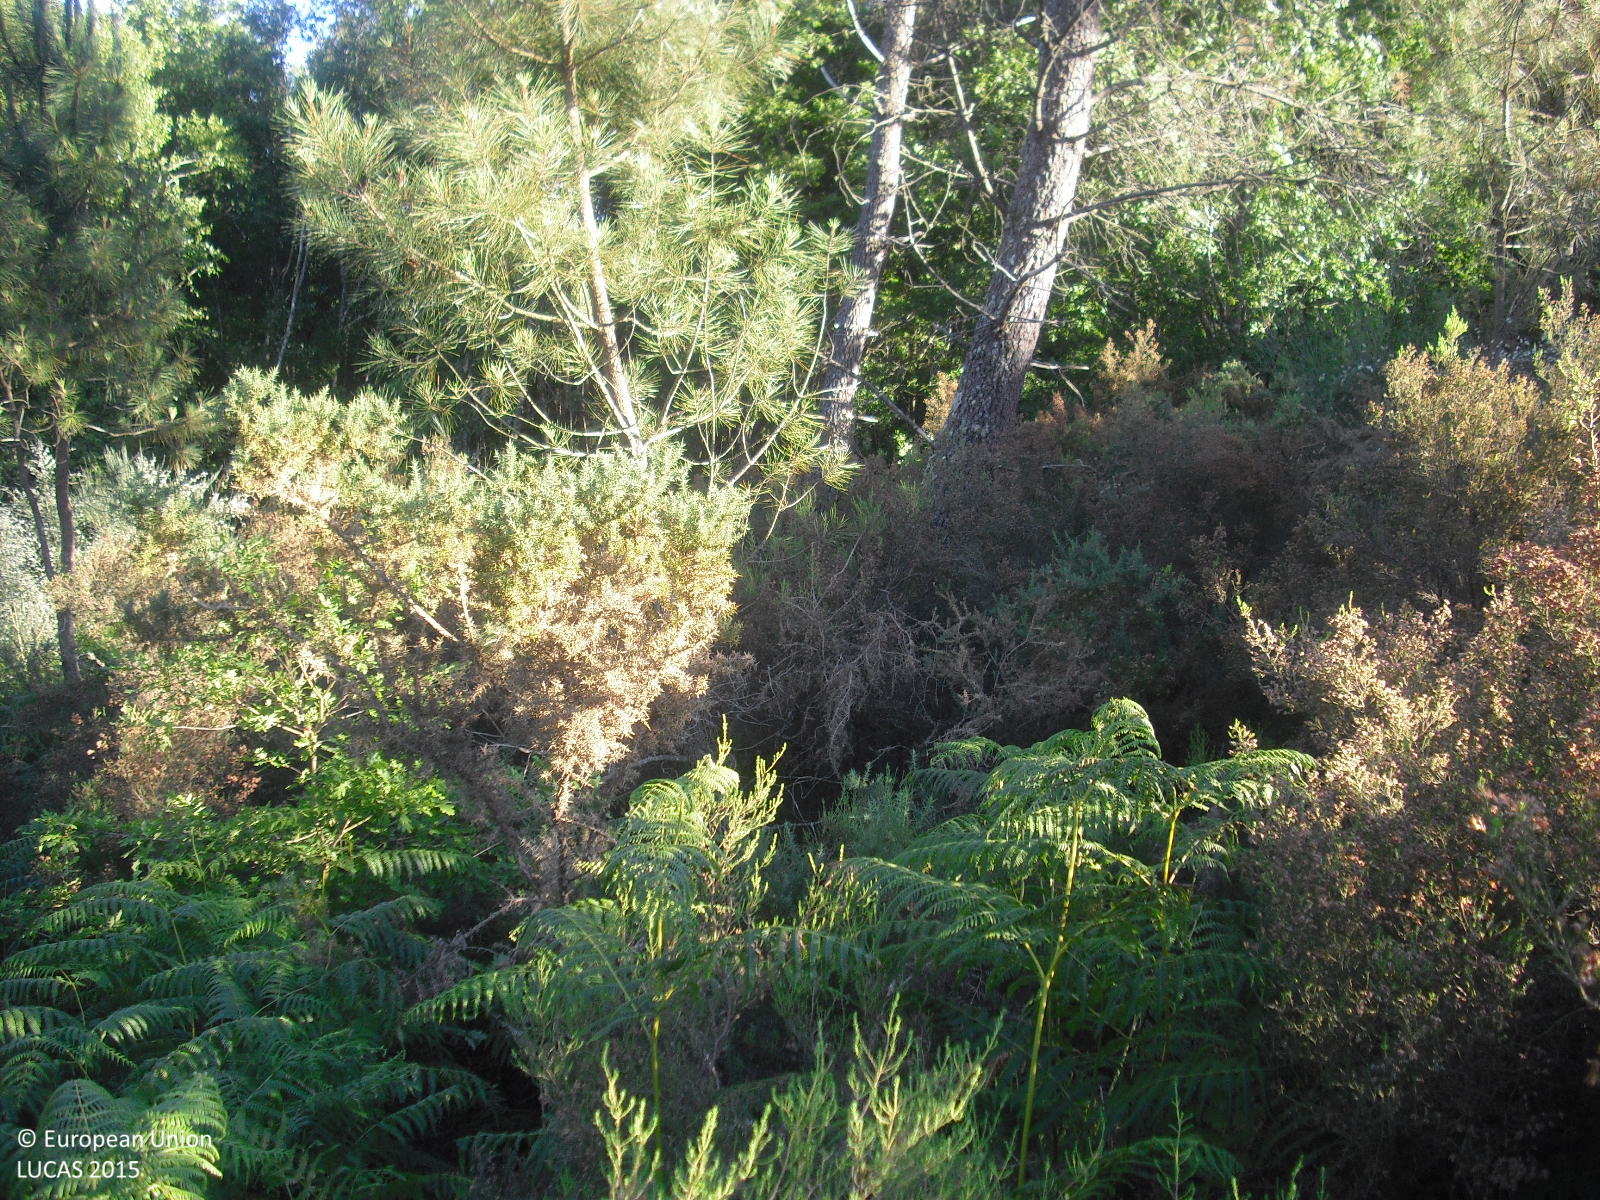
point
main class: Woodland
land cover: Pine dominated mixed woodland
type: hemiboreal forest and nemoral coniferous forest and mixed broadleaved-coniferous forest
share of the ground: 25 - 50 %
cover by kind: shrubs 50 %, coniferous forest trees 30 %, broadleaved forest trees 20 %
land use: Forestry
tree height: > 5 m
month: June
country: ES
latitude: 42.5004
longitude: -7.9075
